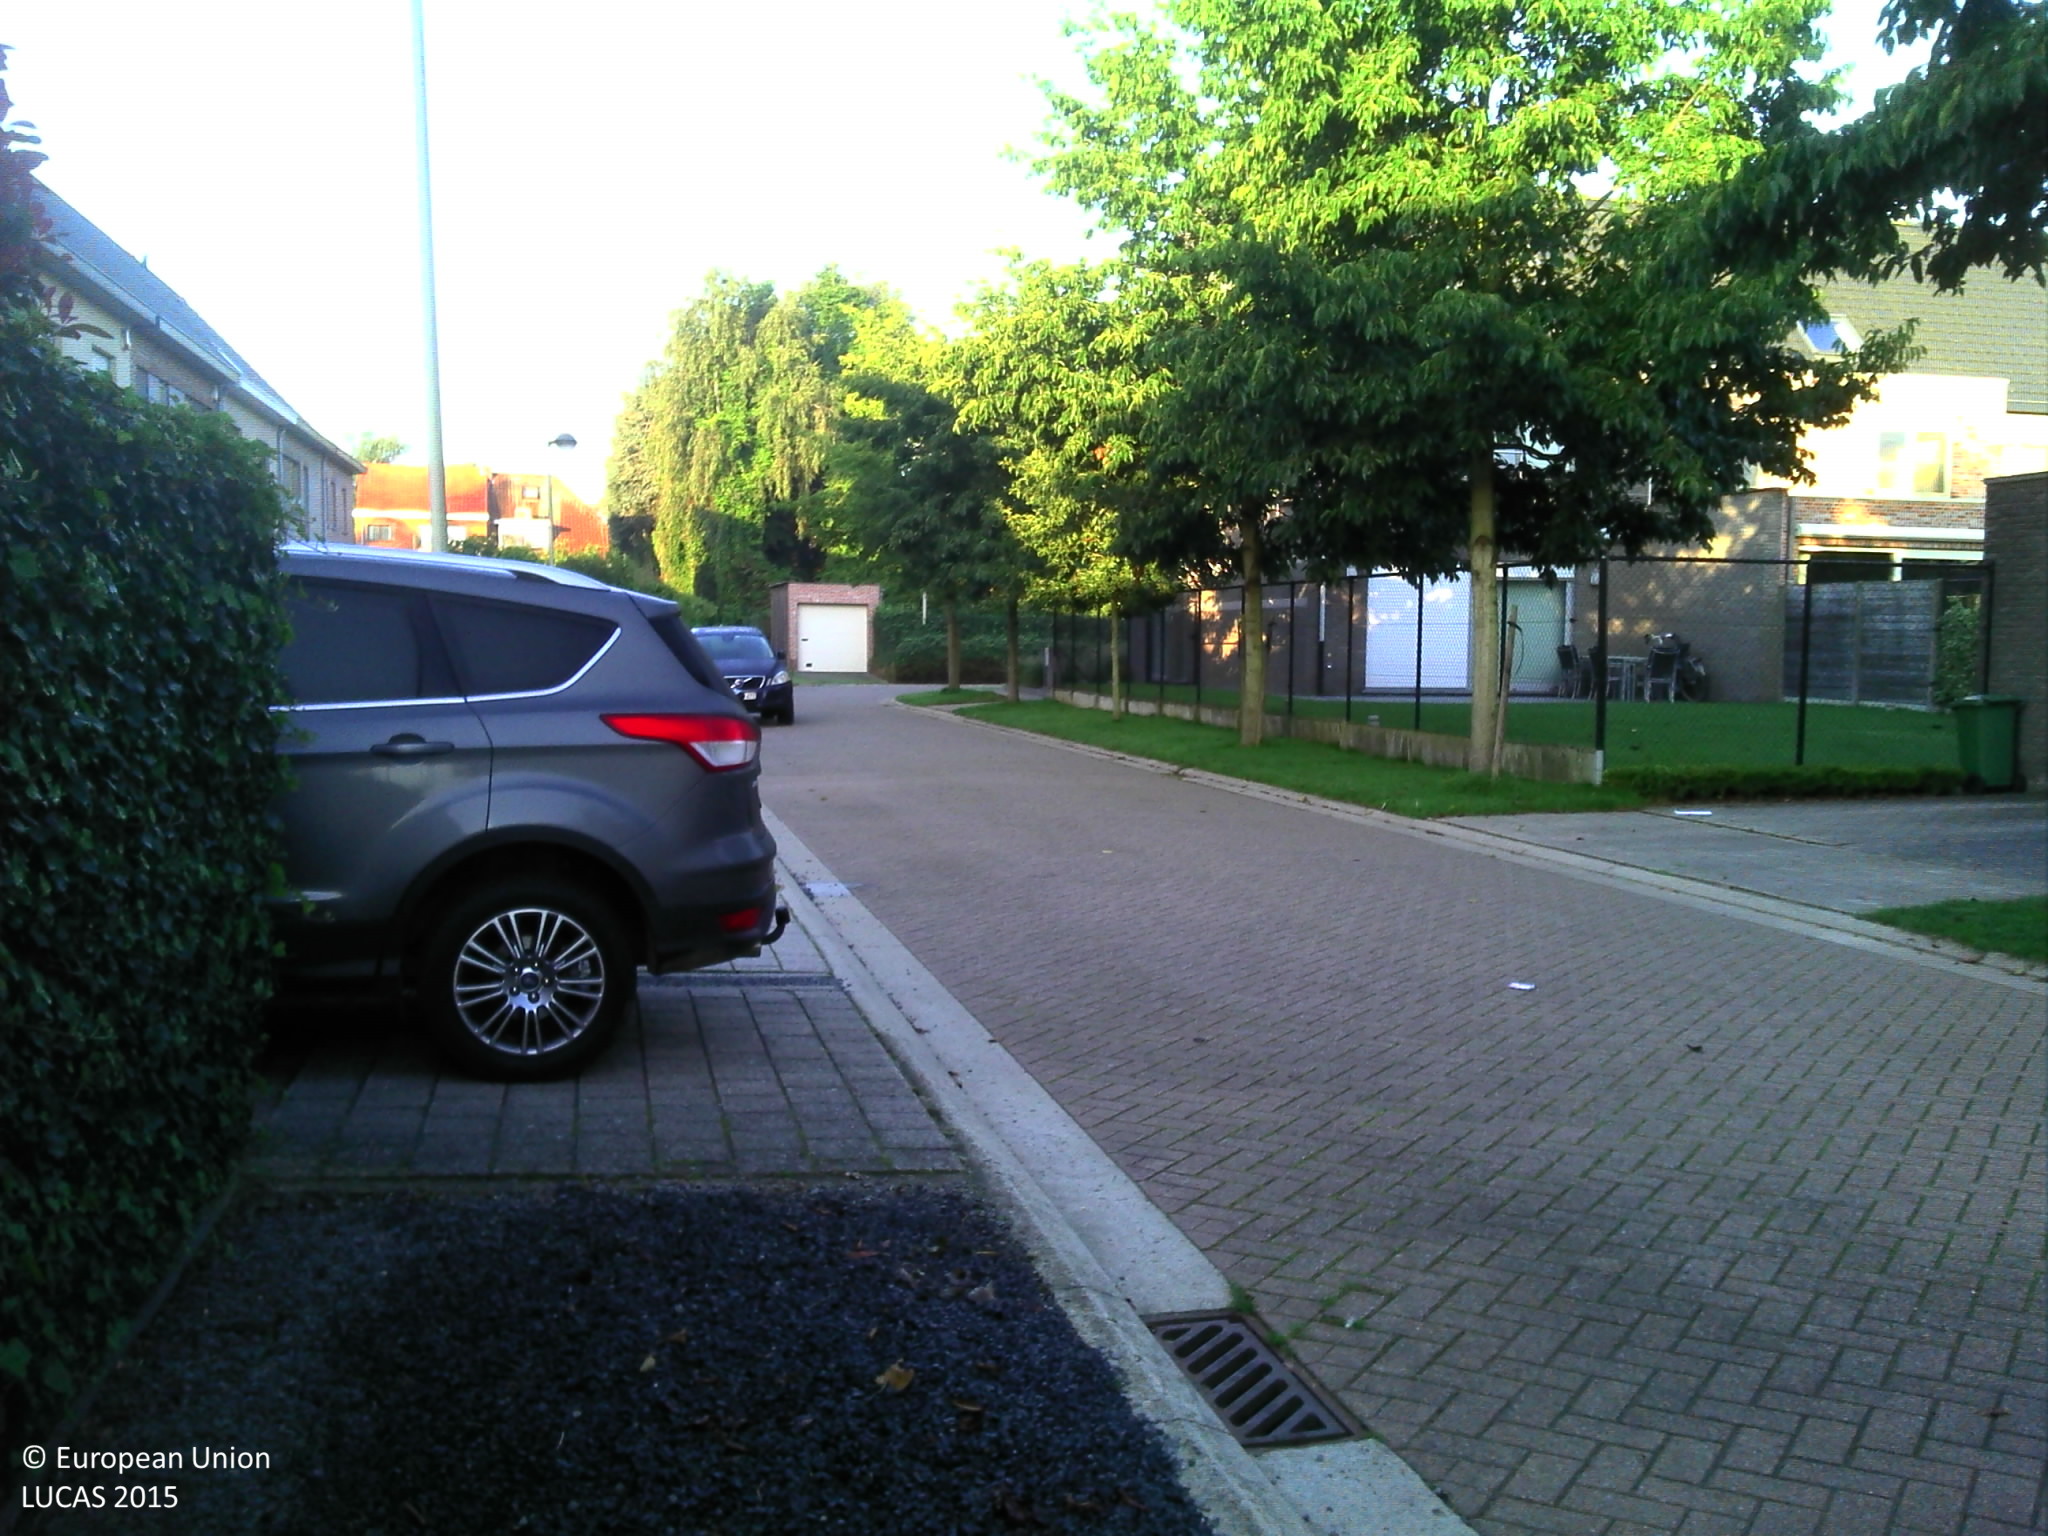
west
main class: Grassland
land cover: Grassland without tree/shrub cover
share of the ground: > 75 %
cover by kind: herbaceous plants 100 %
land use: Residential
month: September
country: BE
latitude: 51.2235
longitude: 4.5117
